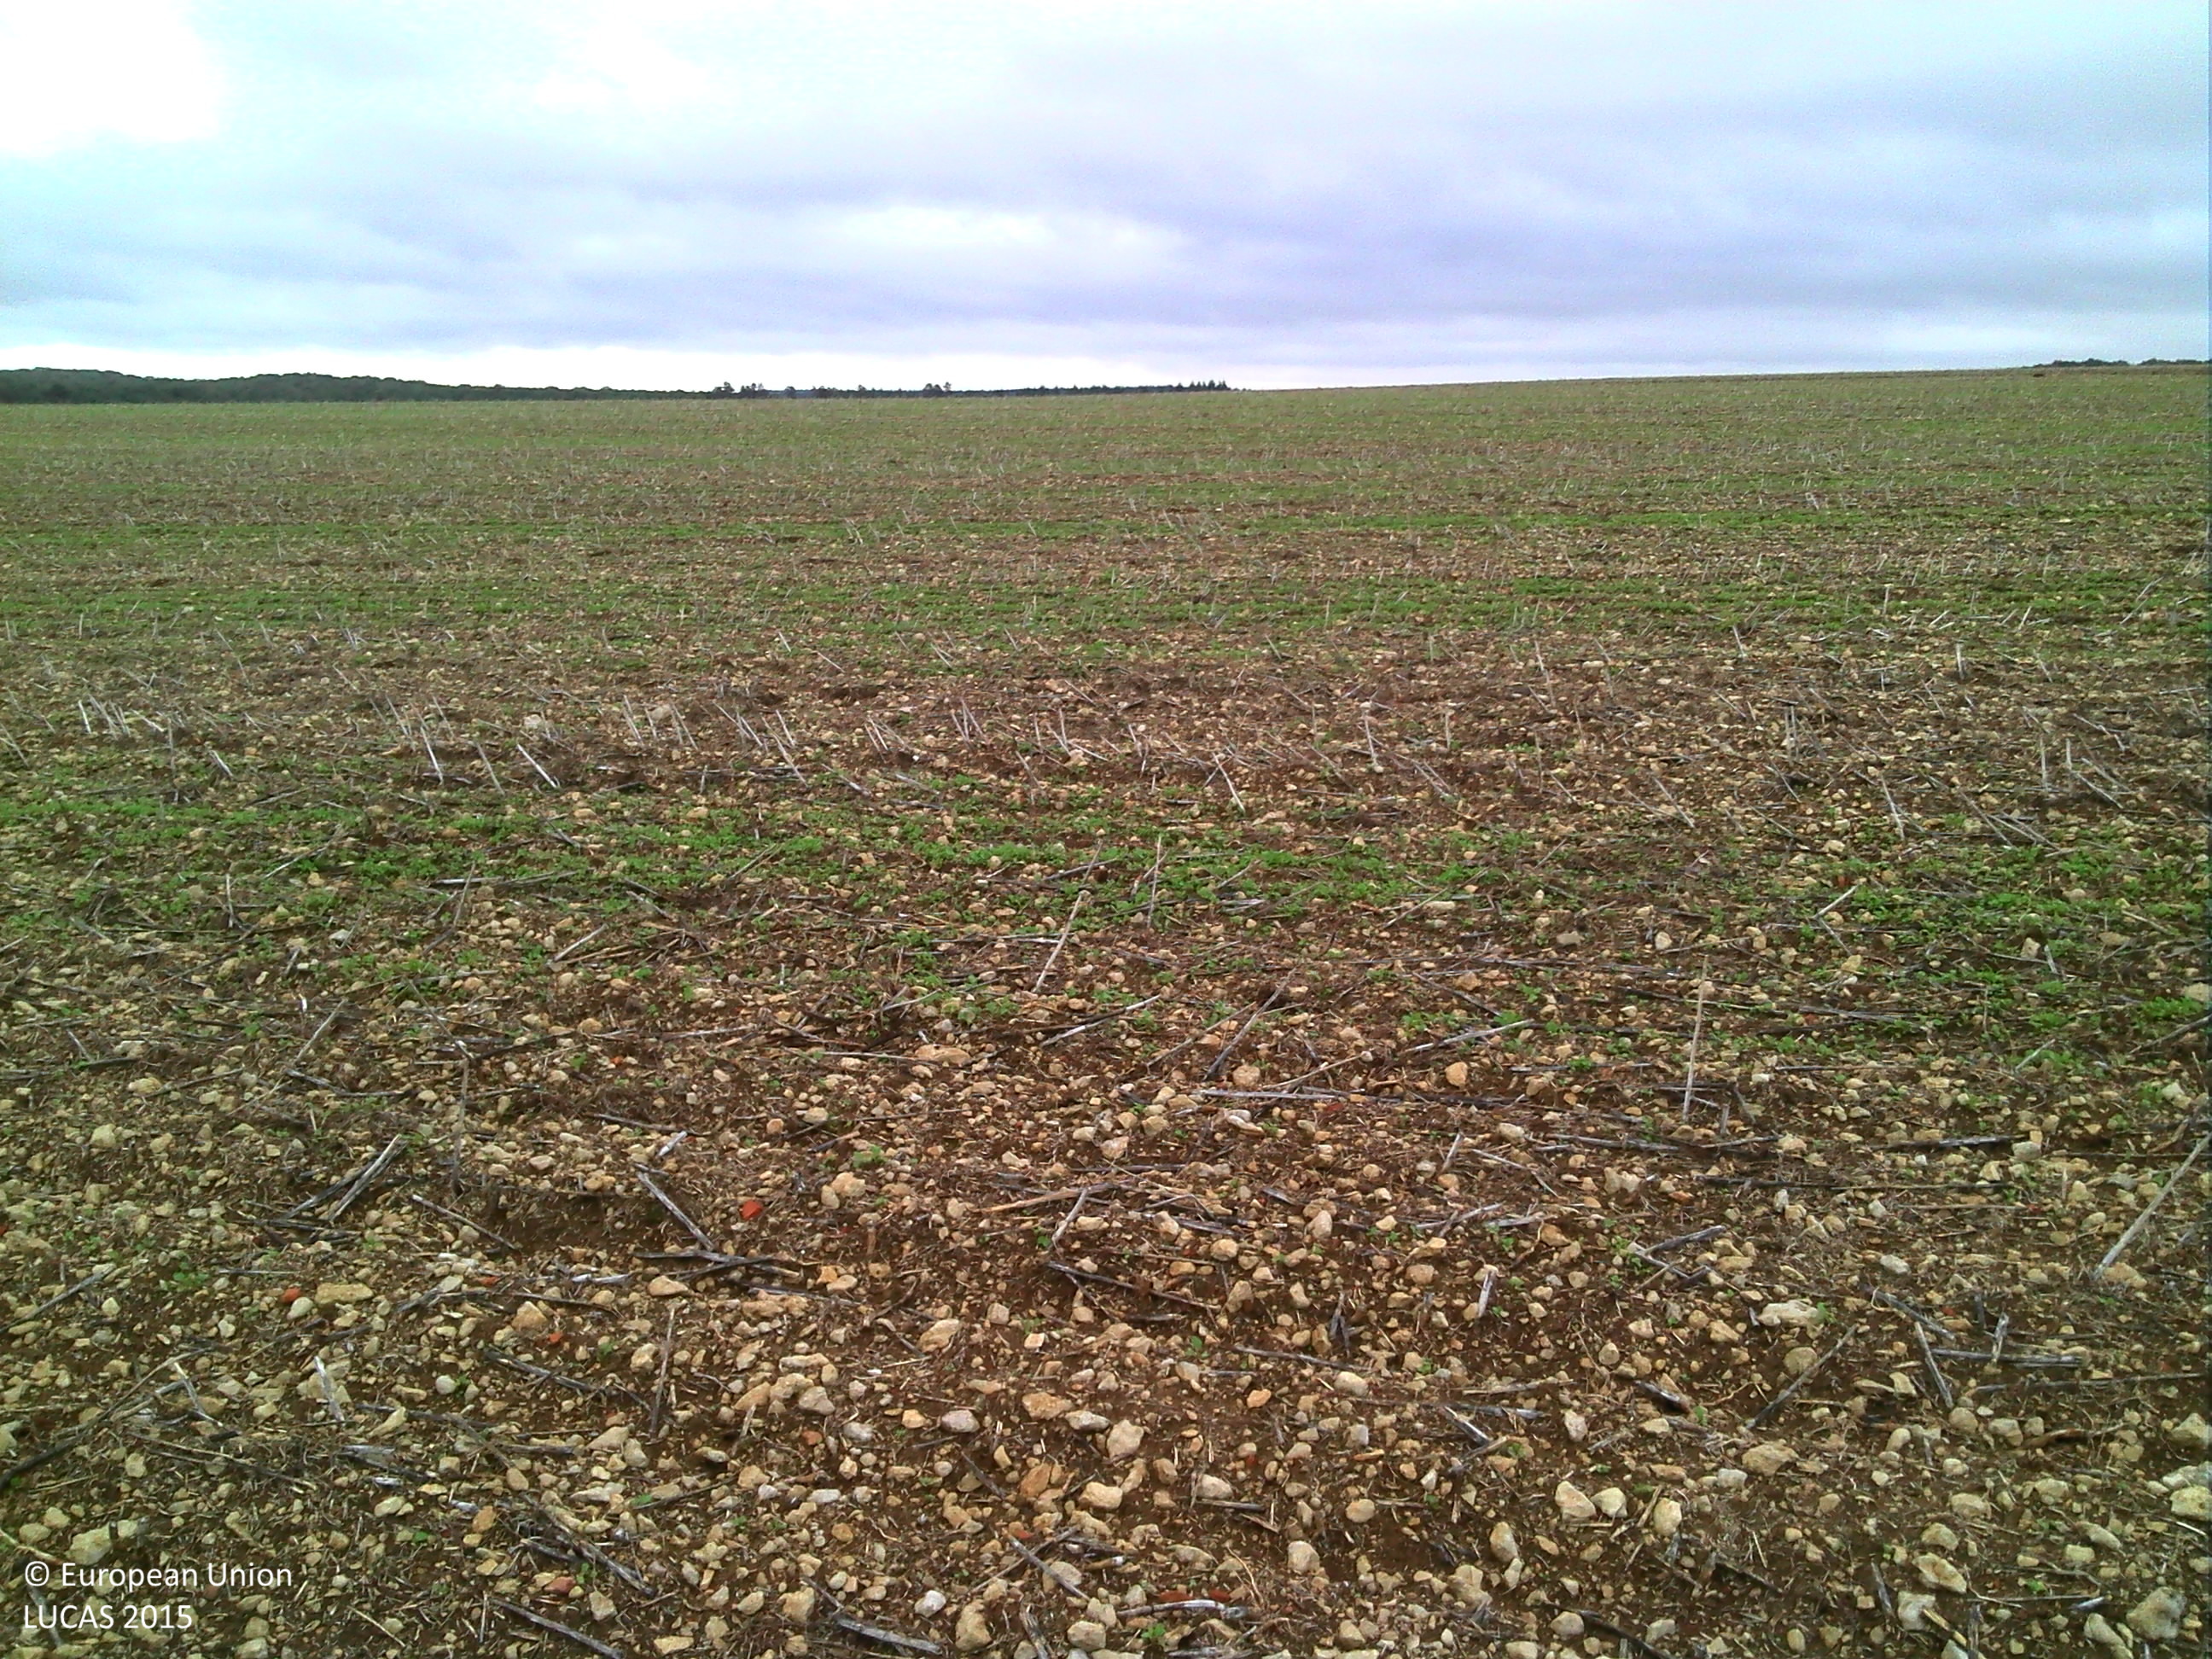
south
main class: Cropland
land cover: Rape and turnip rape
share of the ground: < 10 %
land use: Agriculture (excluding fallow land and kitchen gardens)
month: September
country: FR
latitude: 48.0740
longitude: 4.6161
